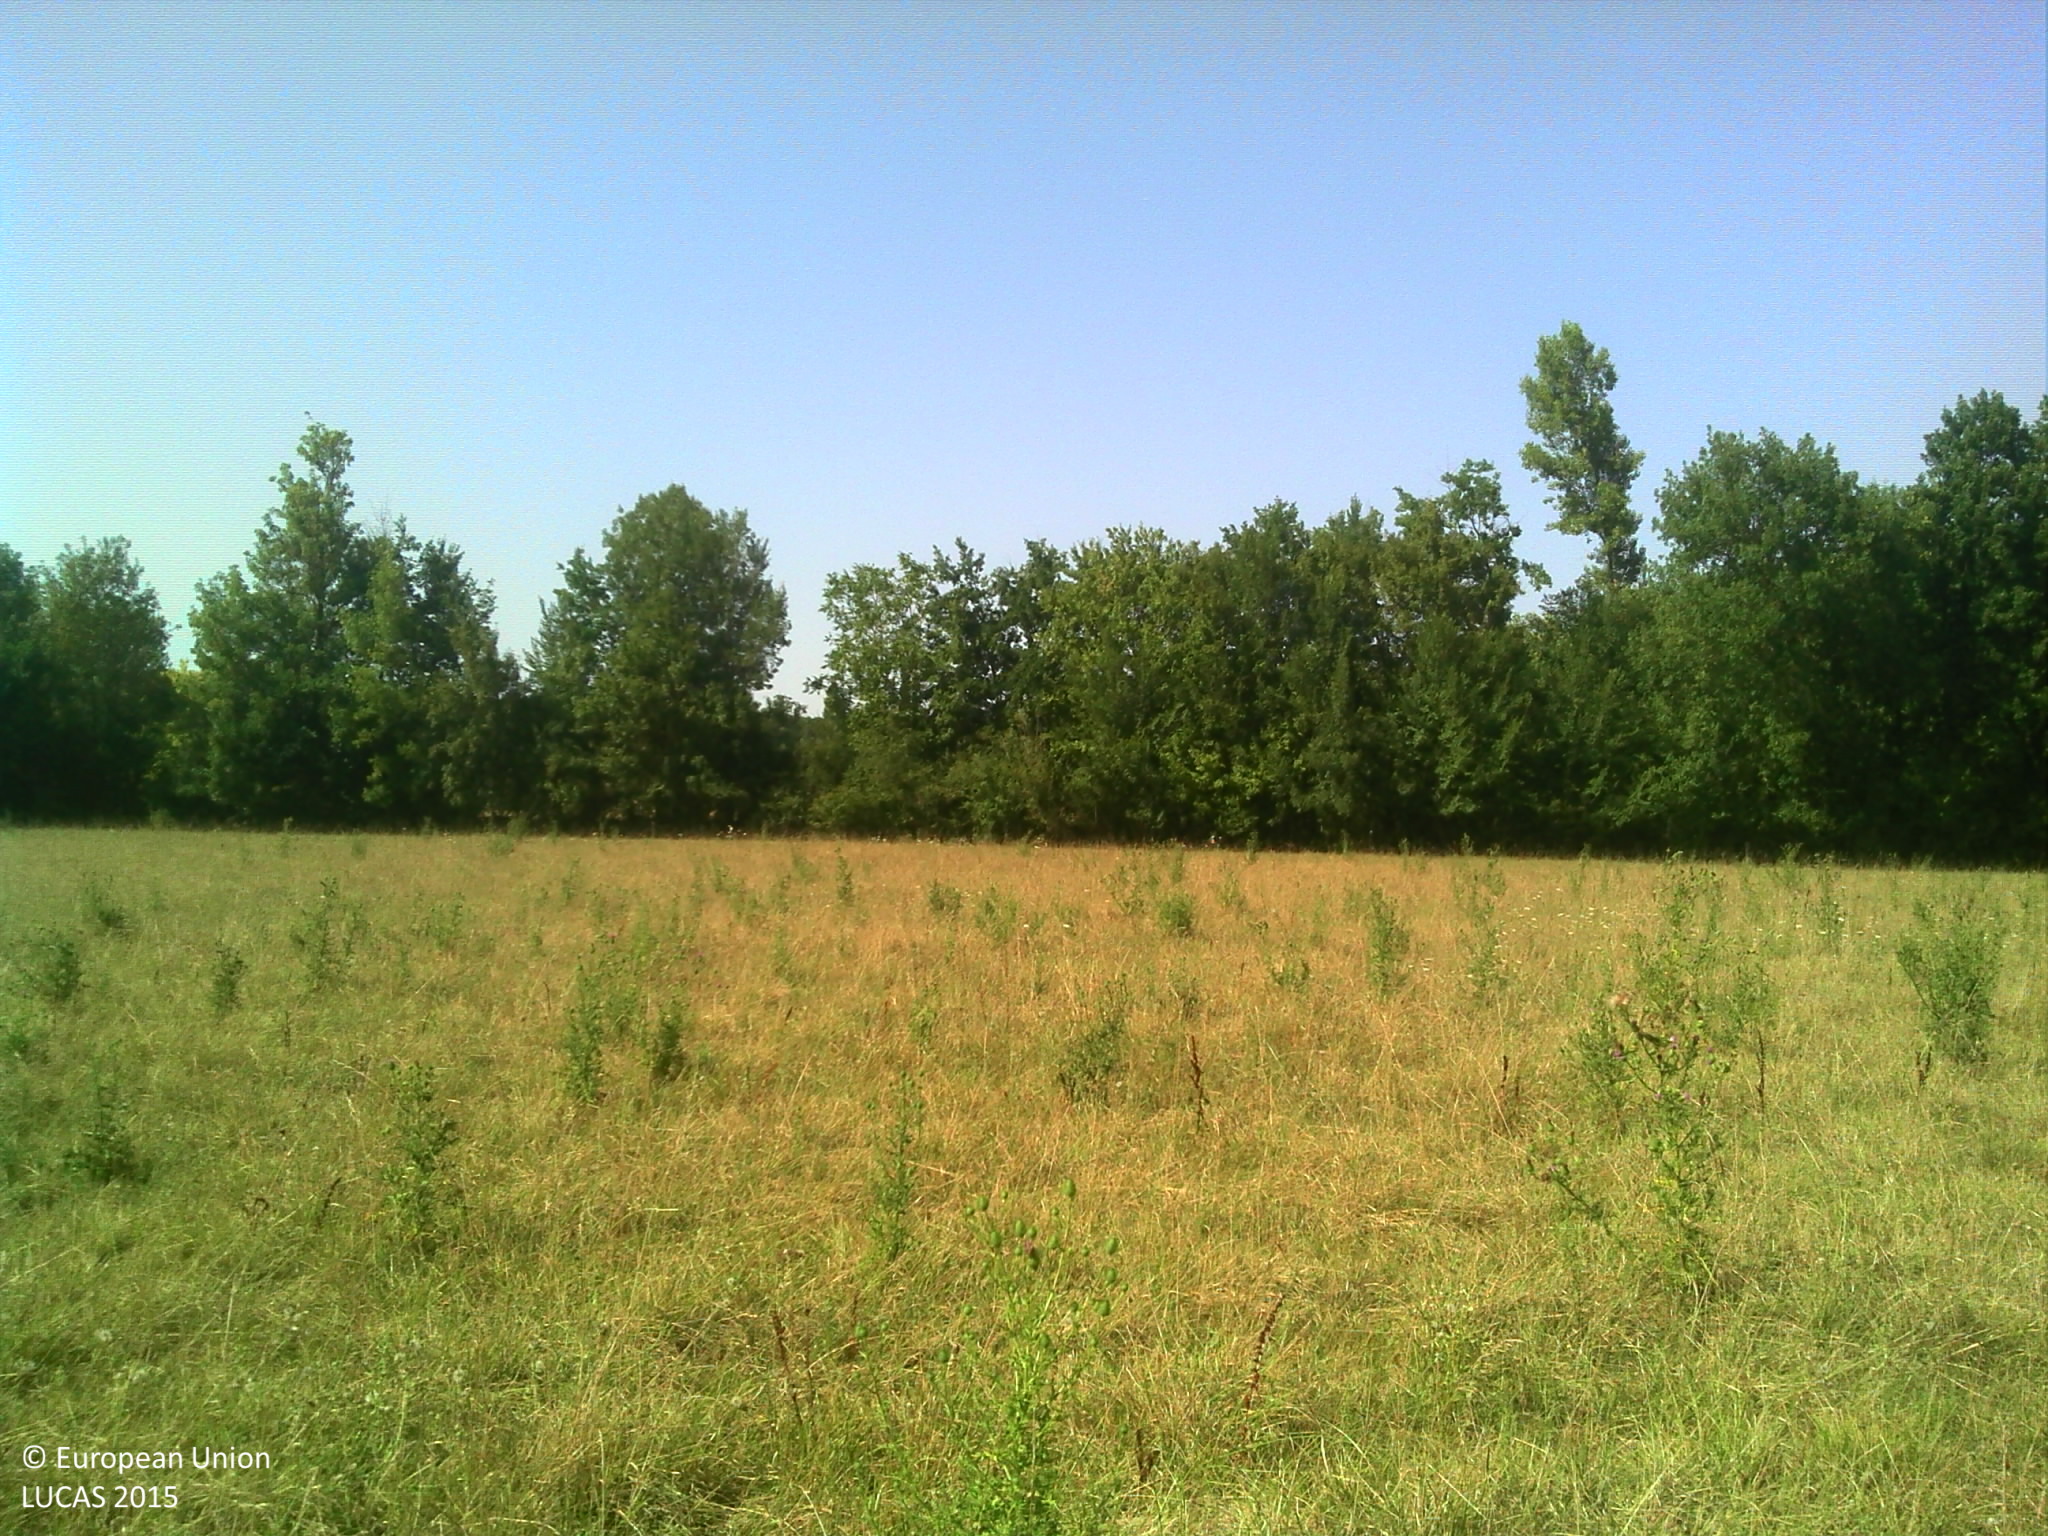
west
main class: Grassland
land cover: Grassland without tree/shrub cover
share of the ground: > 75 %
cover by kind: herbaceous plants 100 %
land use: Agriculture (excluding fallow land and kitchen gardens)
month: August
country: FR
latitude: 44.1666
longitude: 1.3073
